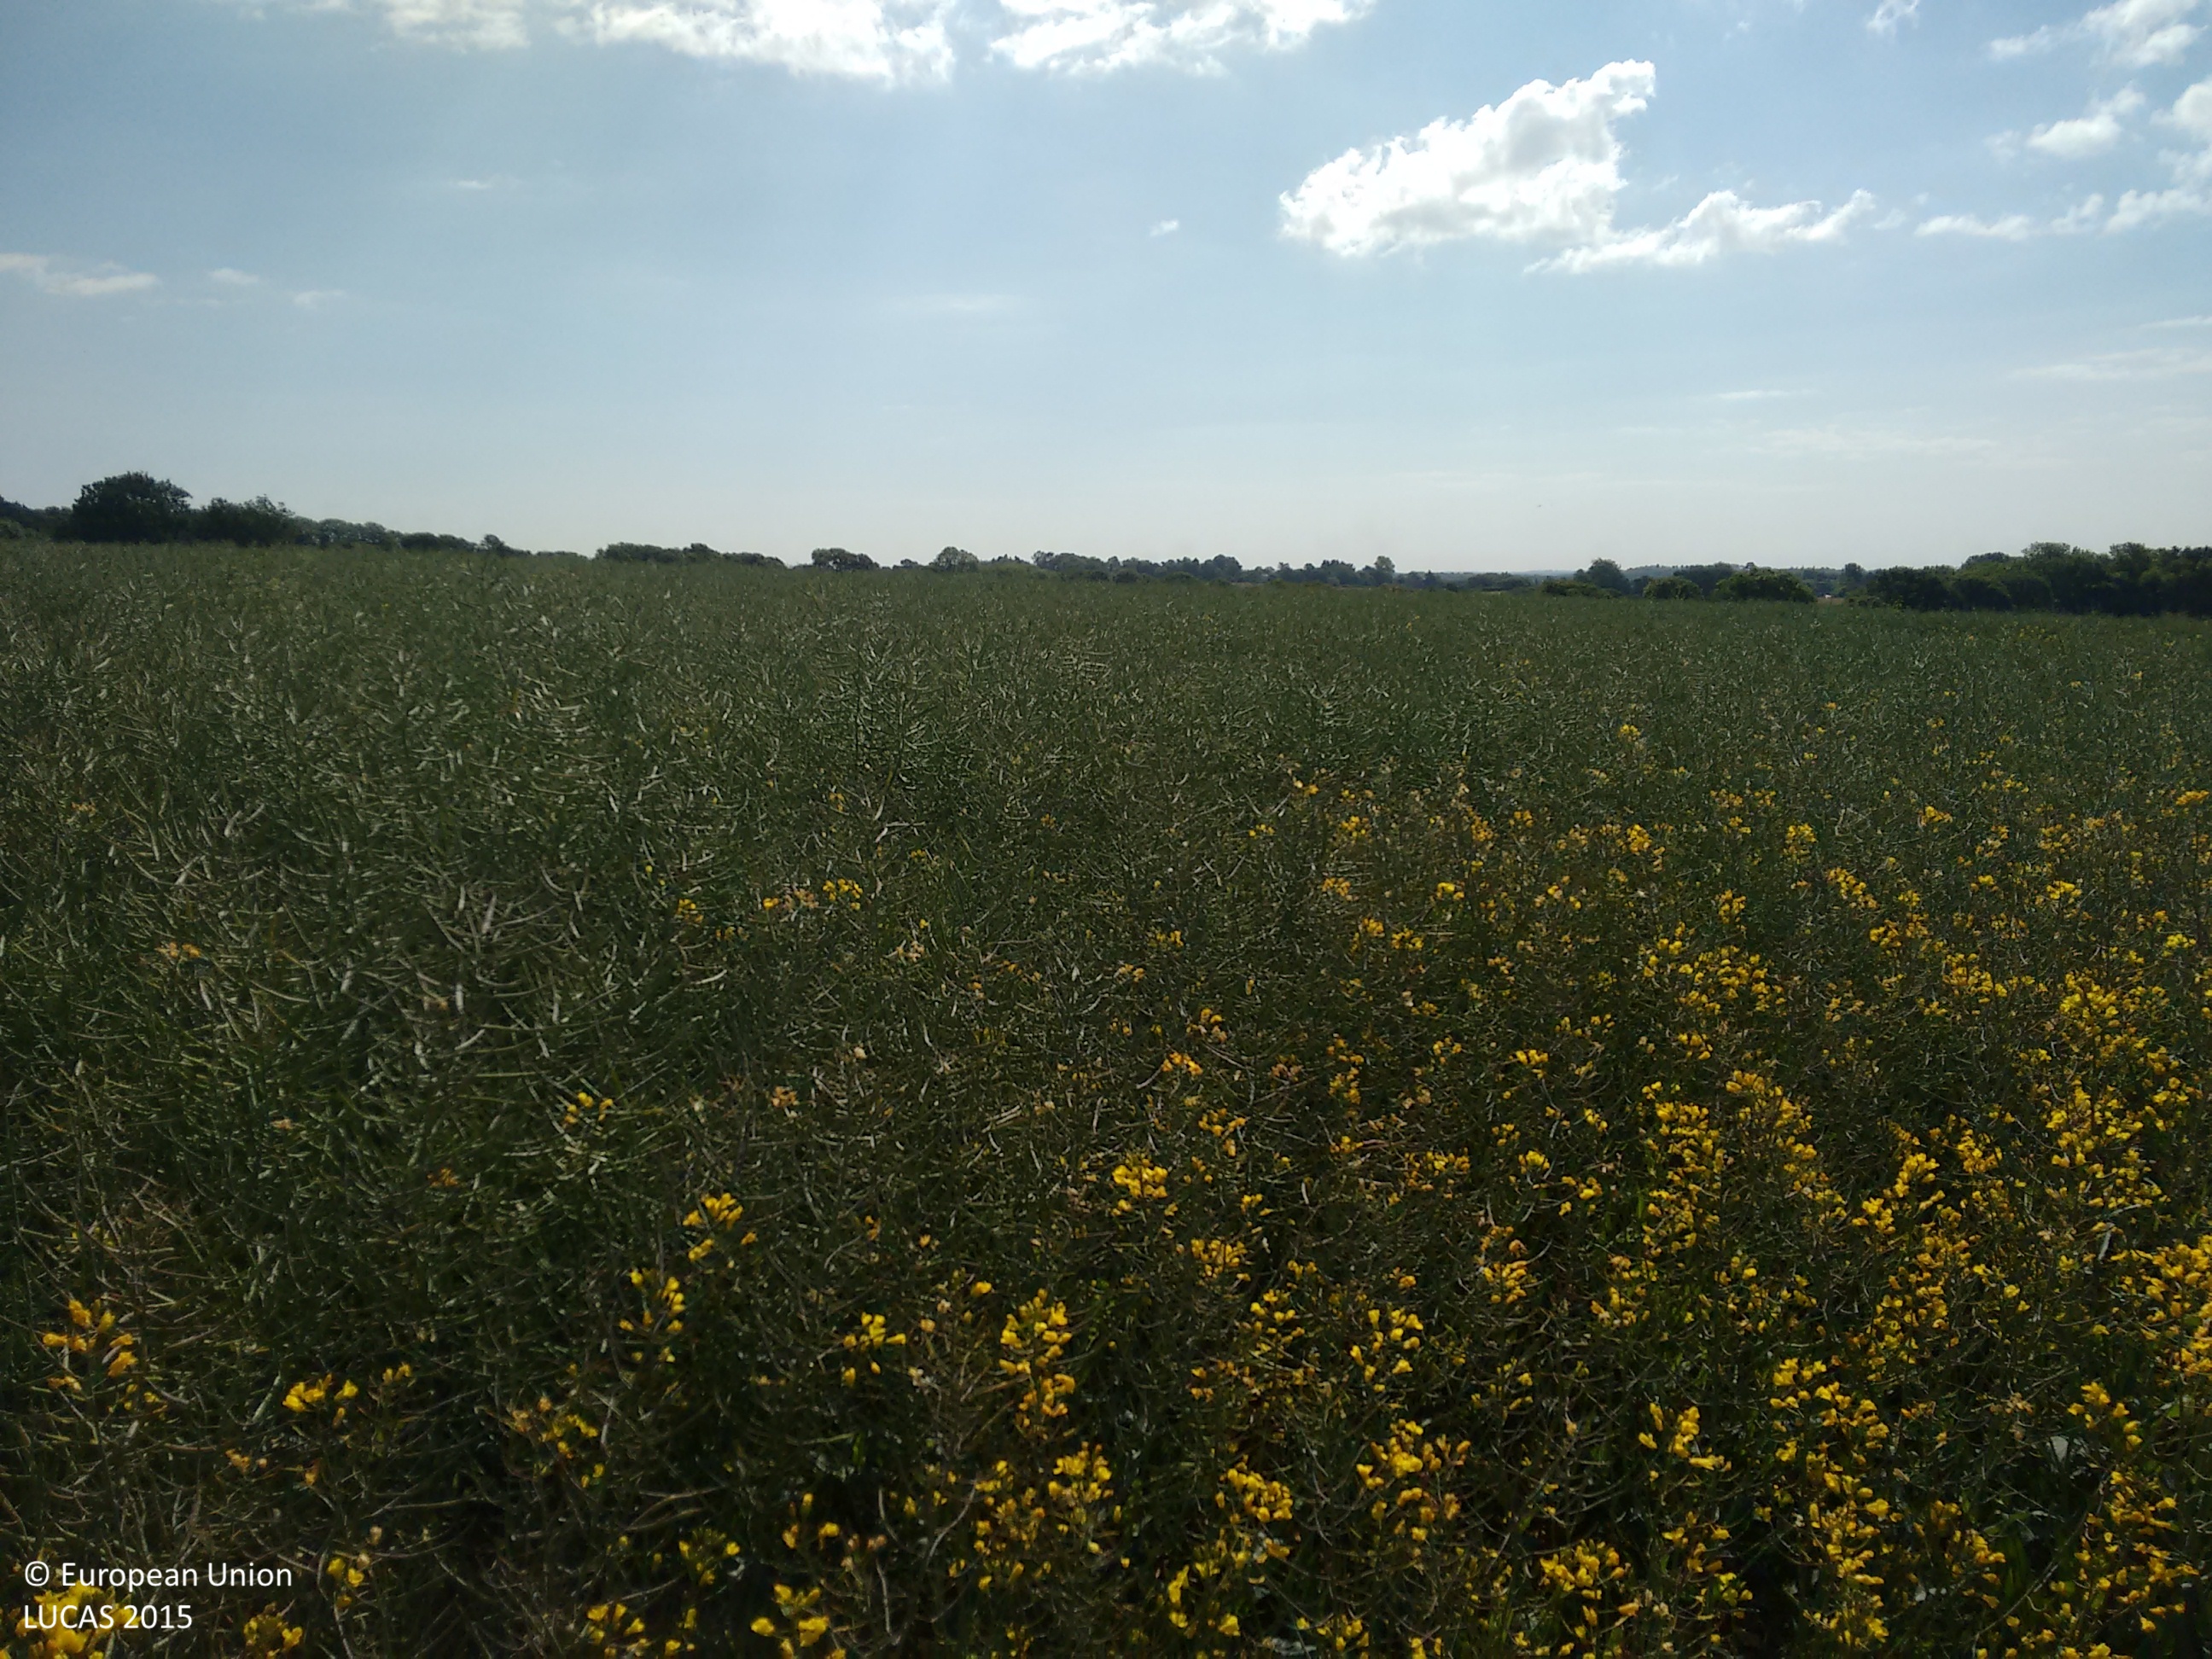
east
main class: Cropland
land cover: Rape and turnip rape
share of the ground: > 75 %
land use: Agriculture (excluding fallow land and kitchen gardens)
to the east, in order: Rape and turnip rape
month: June
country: GB
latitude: 51.0180
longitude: -1.6715
